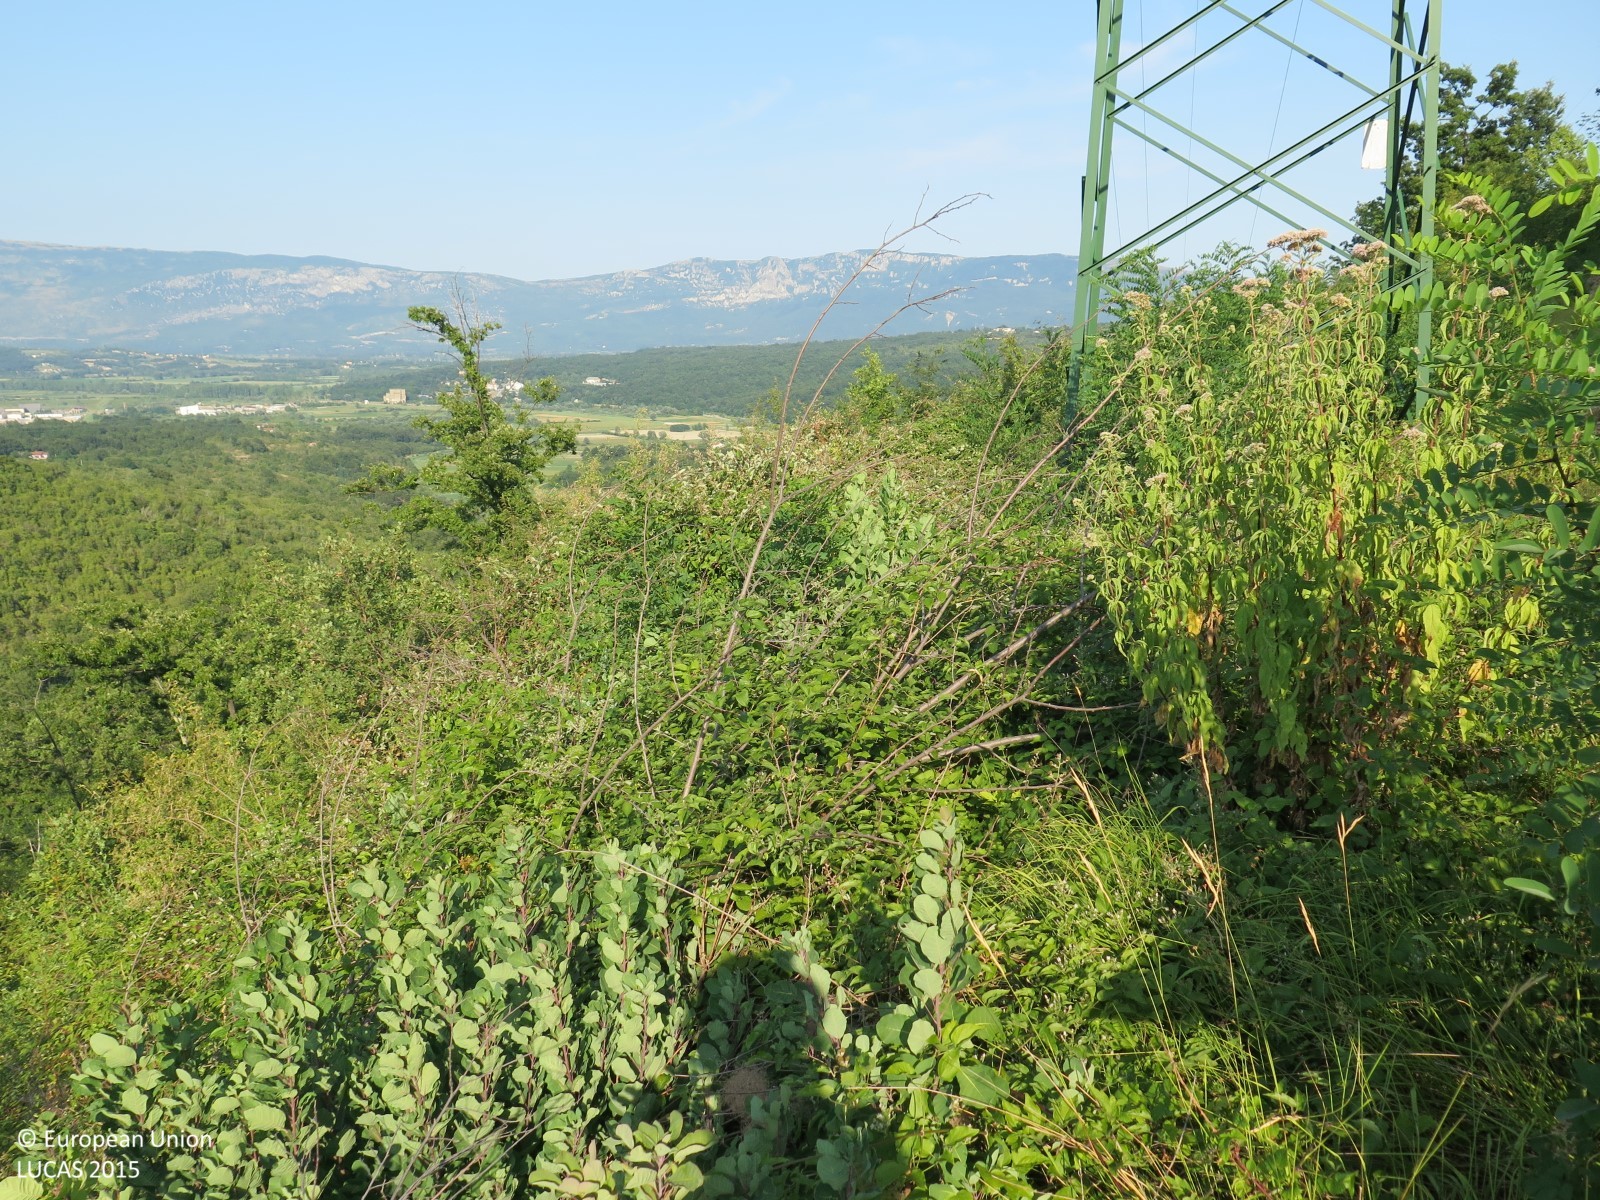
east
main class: Woodland
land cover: Broadleaved woodland
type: acidophilous oak and oak-birch forest
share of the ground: > 75 %
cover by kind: broadleaved forest trees 90 %, shrubs 5 %, herbaceous plants 5 %
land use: Semi-natural and natural areas not in use
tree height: > 5 m
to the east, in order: Broadleaved woodland
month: July
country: HR
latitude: 45.1920
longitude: 14.0550
